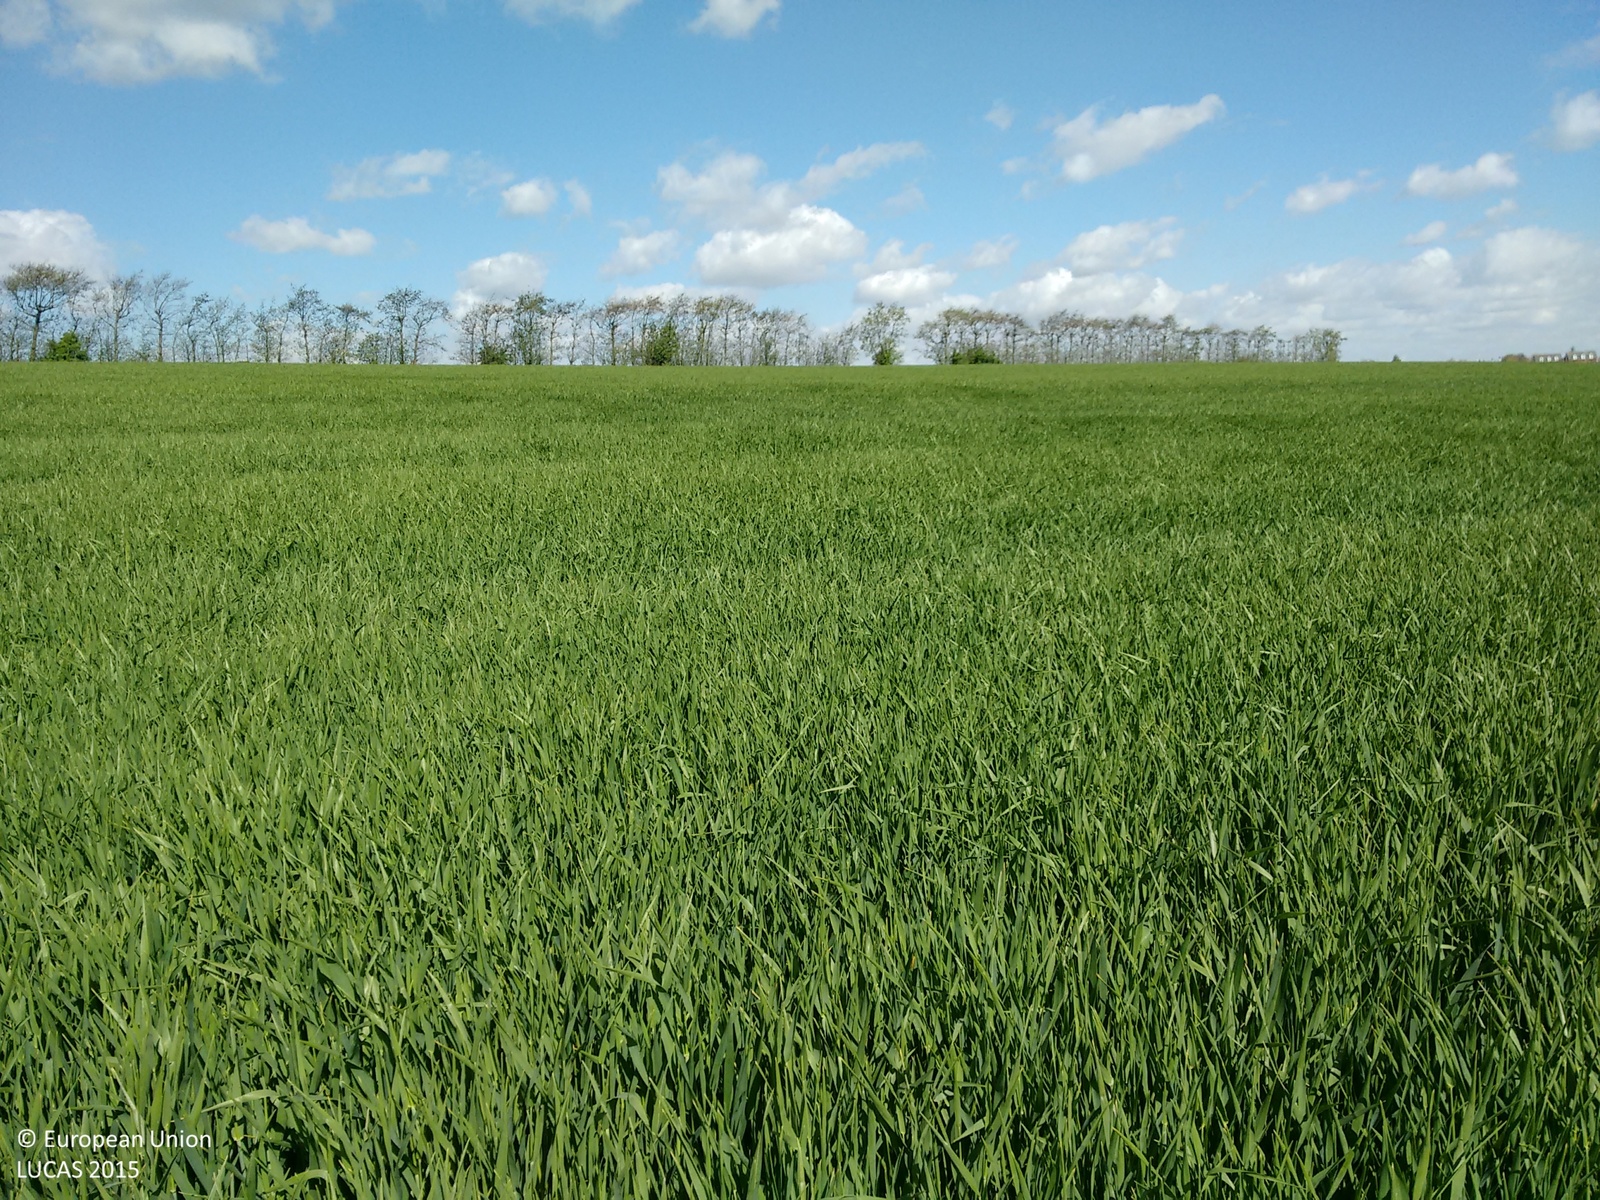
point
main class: Cropland
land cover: Barley
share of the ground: > 75 %
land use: Agriculture (excluding fallow land and kitchen gardens)
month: April
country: GB
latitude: 51.3276
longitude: 0.7465
